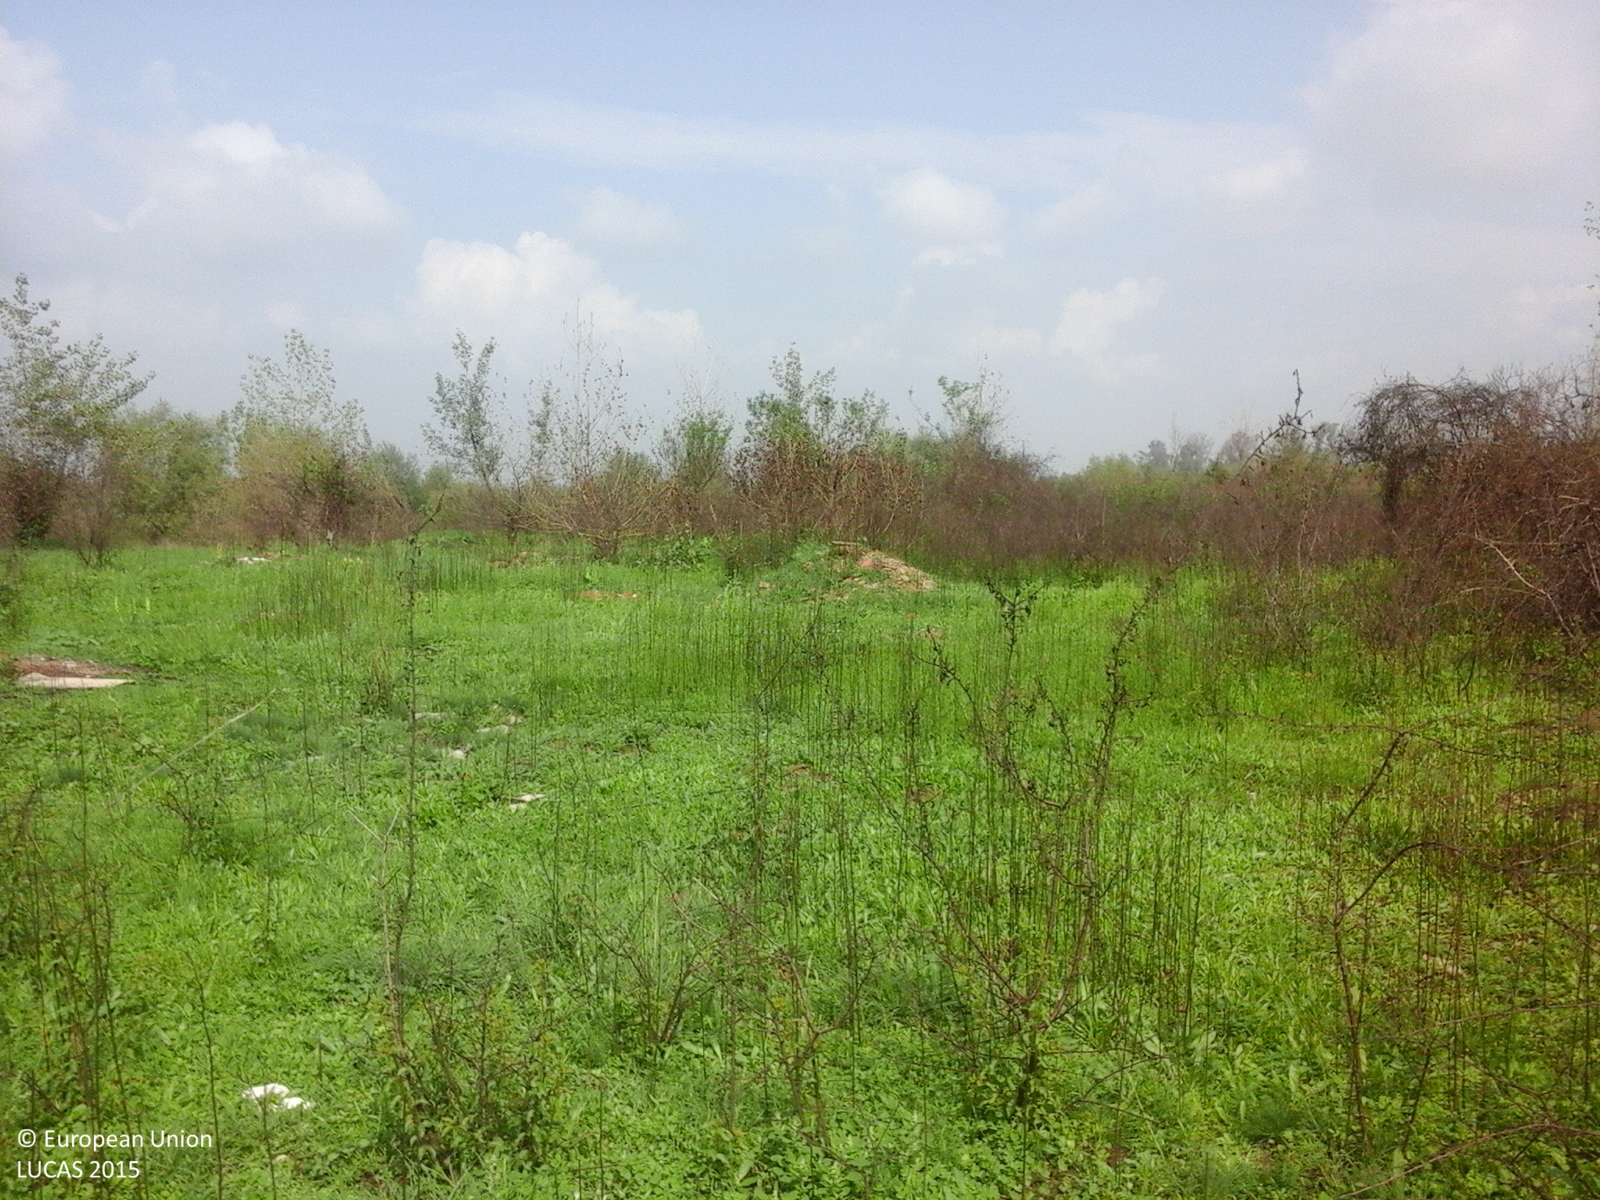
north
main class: Shrubland
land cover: Shrubland with sparse tree cover
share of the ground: > 75 %
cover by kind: shrubs 95 %, broadleaved forest trees 5 %
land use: Semi-natural and natural areas not in use
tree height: > 5 m
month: September
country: RO
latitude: 44.9780
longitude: 23.2283
